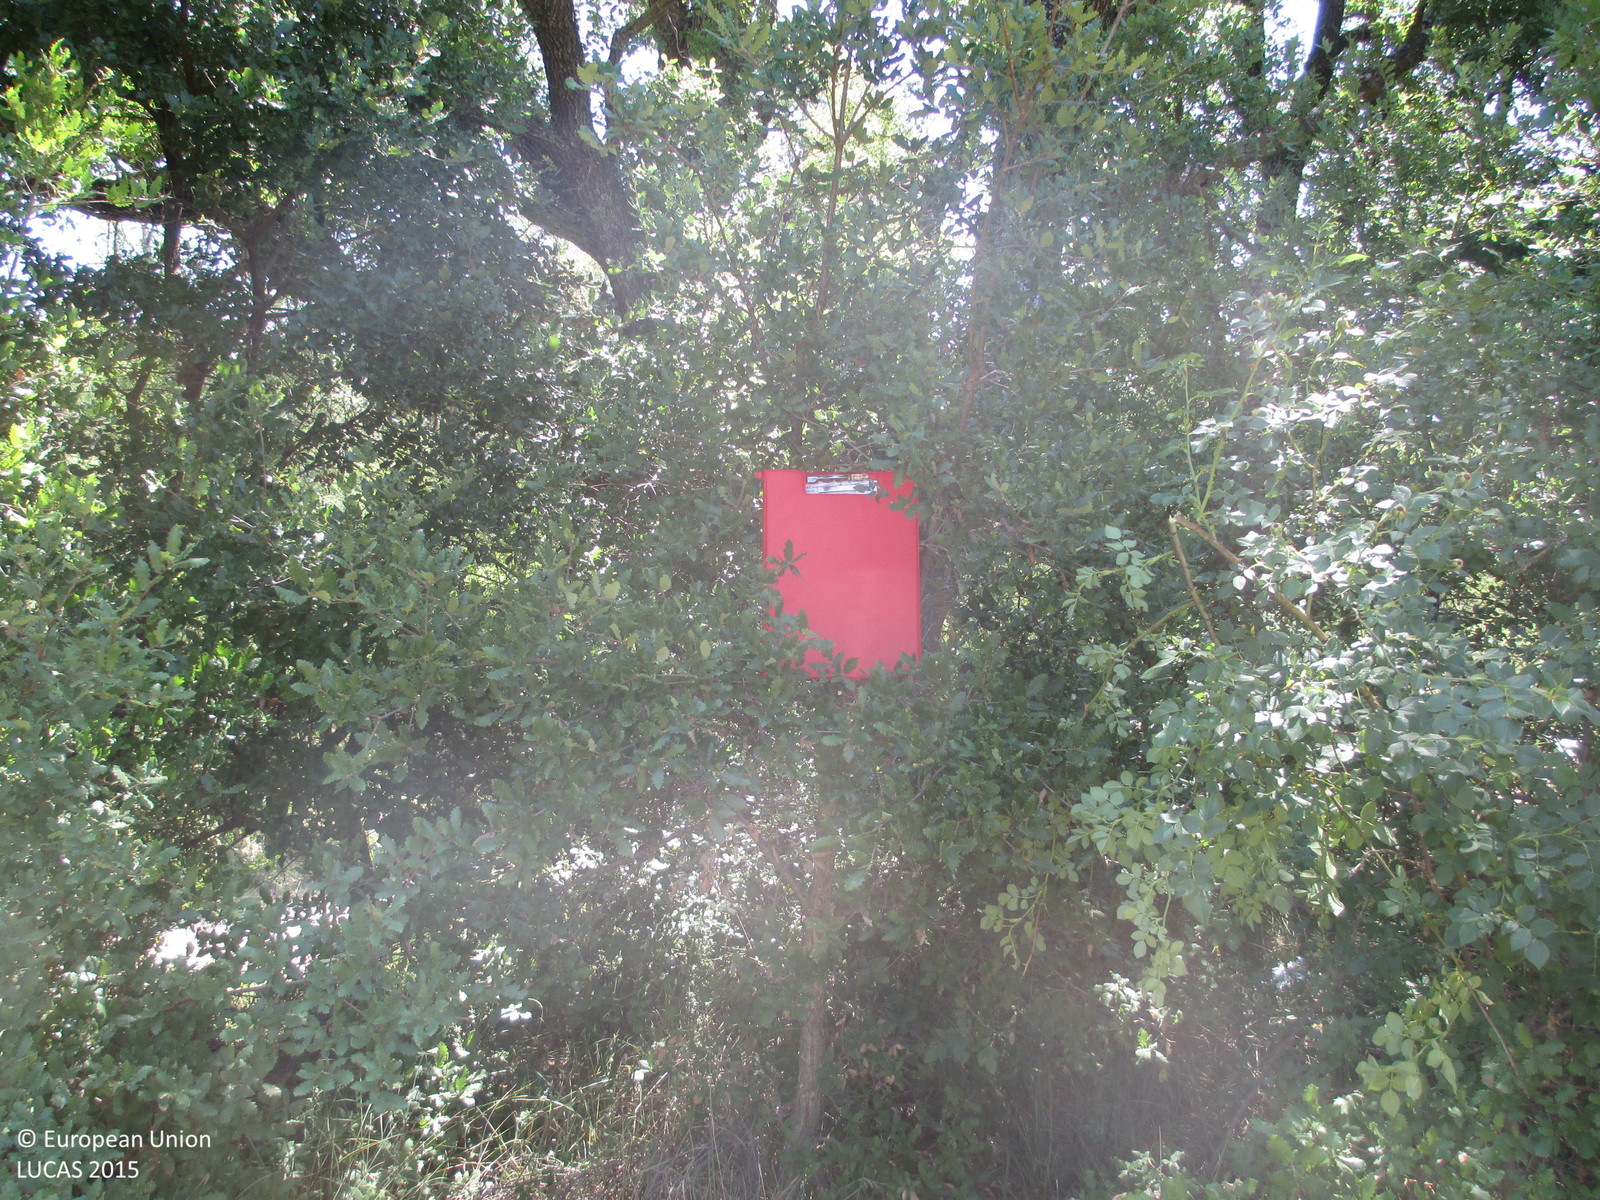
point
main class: Woodland
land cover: Broadleaved woodland
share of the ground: > 75 %
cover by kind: broadleaved forest trees 95 %, shrubs 5 %
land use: Semi-natural and natural areas not in use
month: June
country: ES
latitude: 42.1420
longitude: 0.0222
